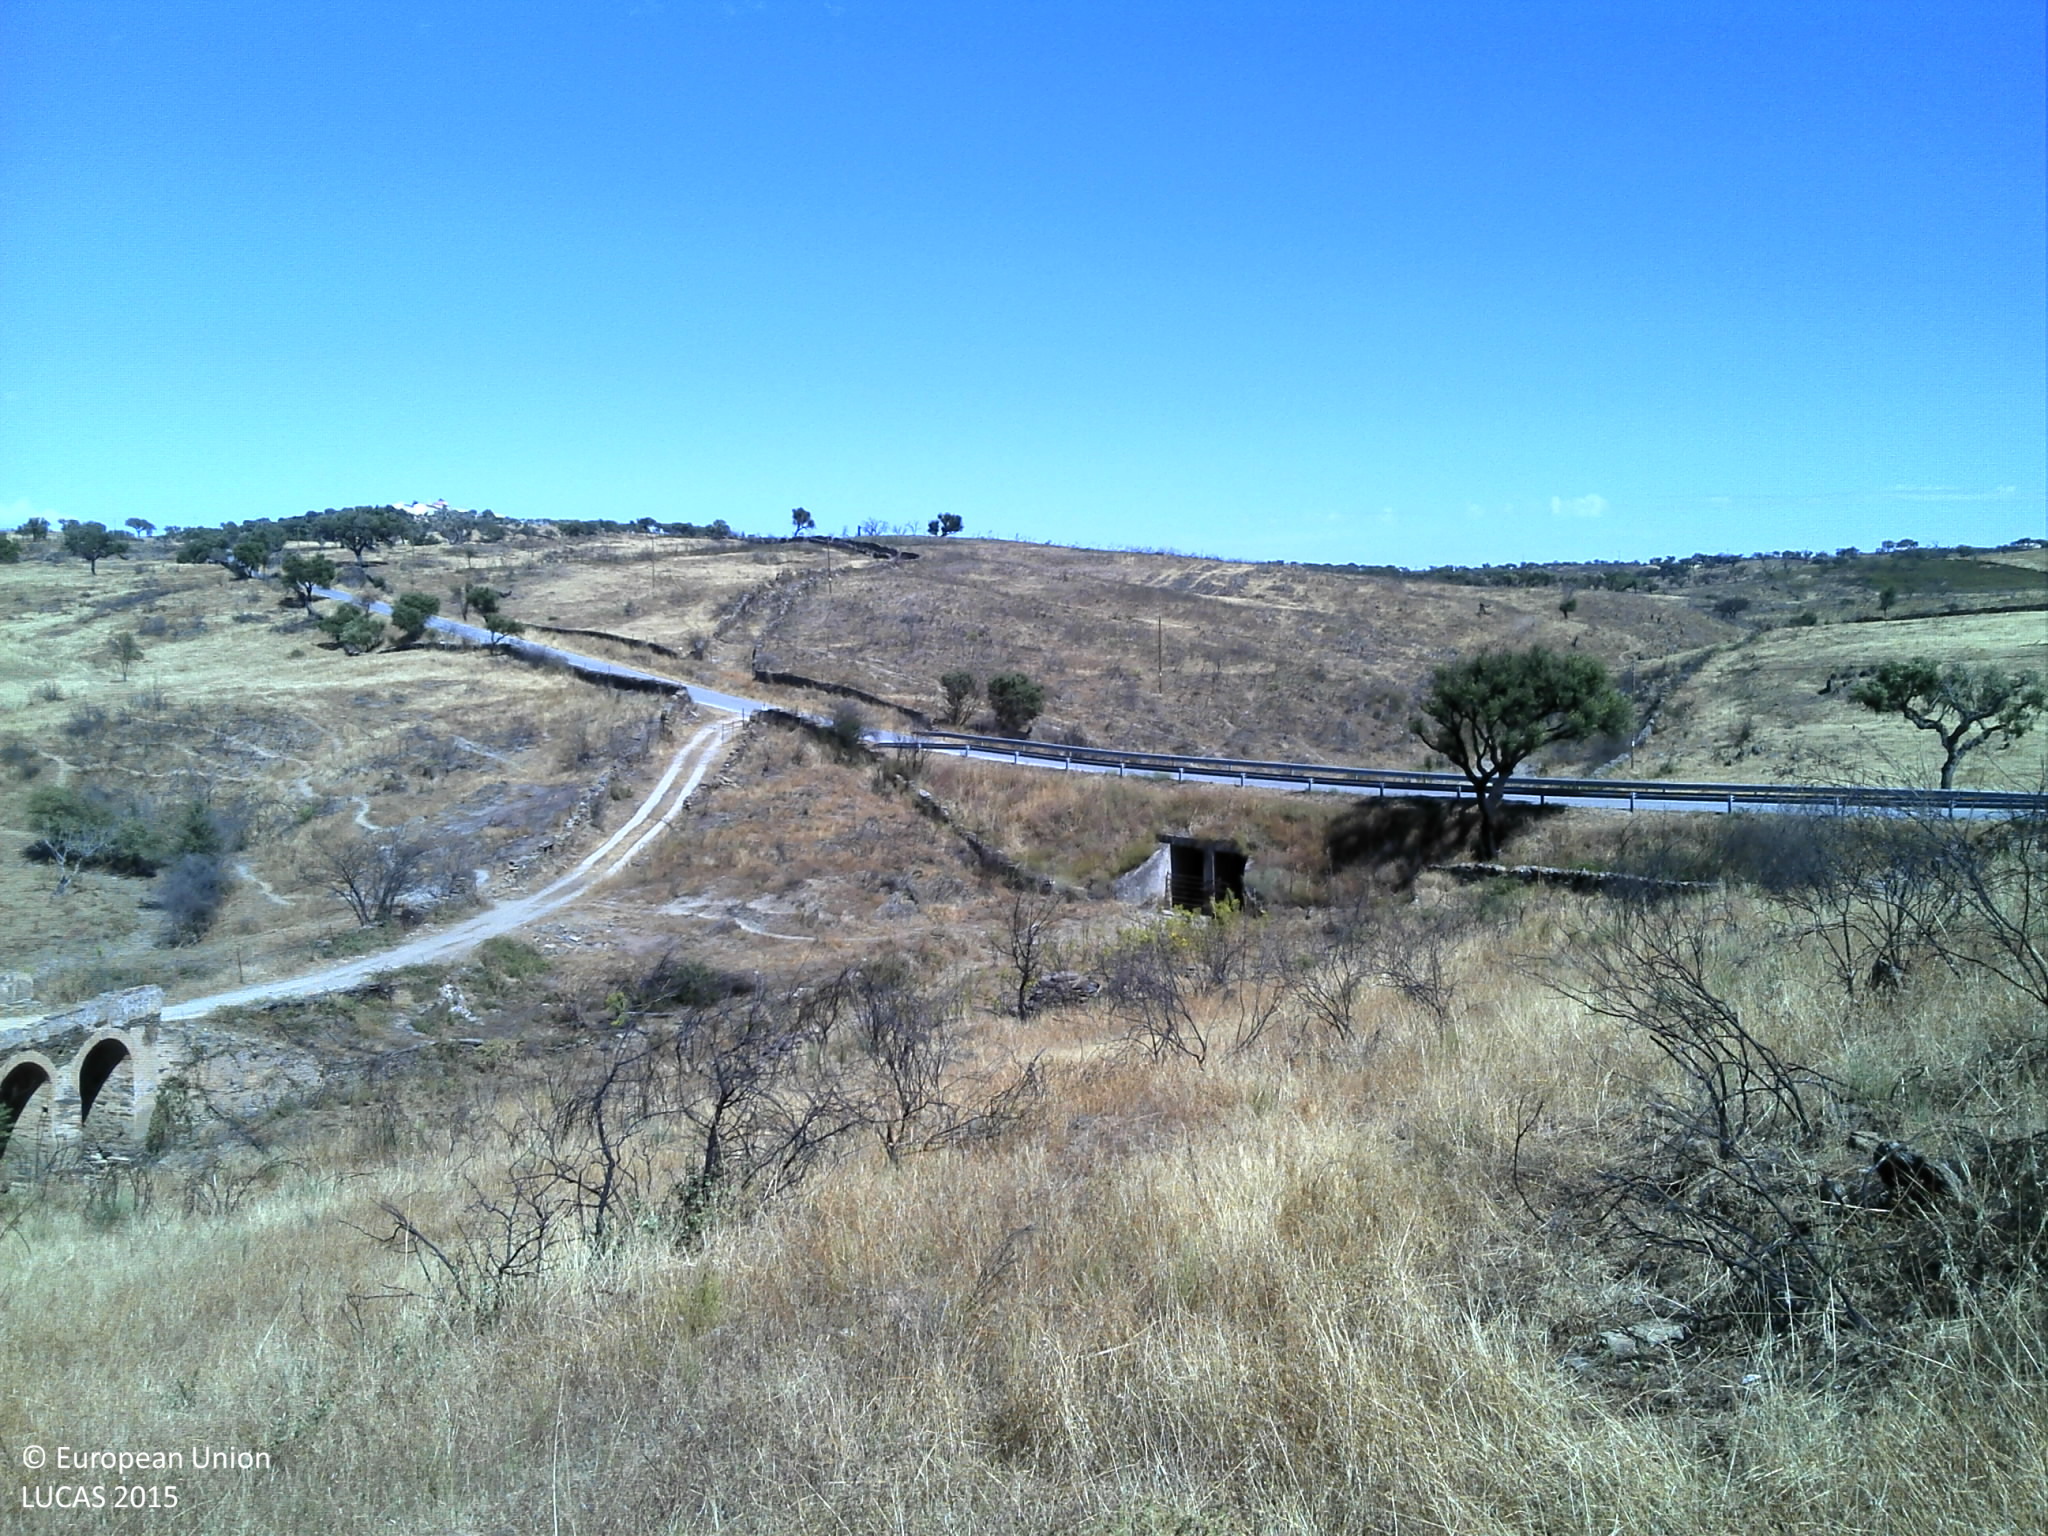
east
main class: Grassland
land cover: Grassland without tree/shrub cover
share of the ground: > 75 %
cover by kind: herbaceous plants 80 %, unconsolidated bare surface 10 %, shrubs 5 %, consolidated bare surface 5 %
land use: Agriculture (excluding fallow land and kitchen gardens)
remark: Burnt area
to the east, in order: Grassland without tree/shrub cover; Rivers and streams; Grassland with sparse tree/shrub cover; Shrubland with sparse tree cover; Rock outcrops; Tracks; Dry stone walls; Fences; Grassland without tree/shrub cover; Fences; Dry stone walls; Ditches and canals; Paved roads, cycling and walking lanes; Ditches and canals; Grass margins; Dry stone walls; Fences; Grass margins; Shrubland without tree cover
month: August
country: PT
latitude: 39.5942
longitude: -7.5517
